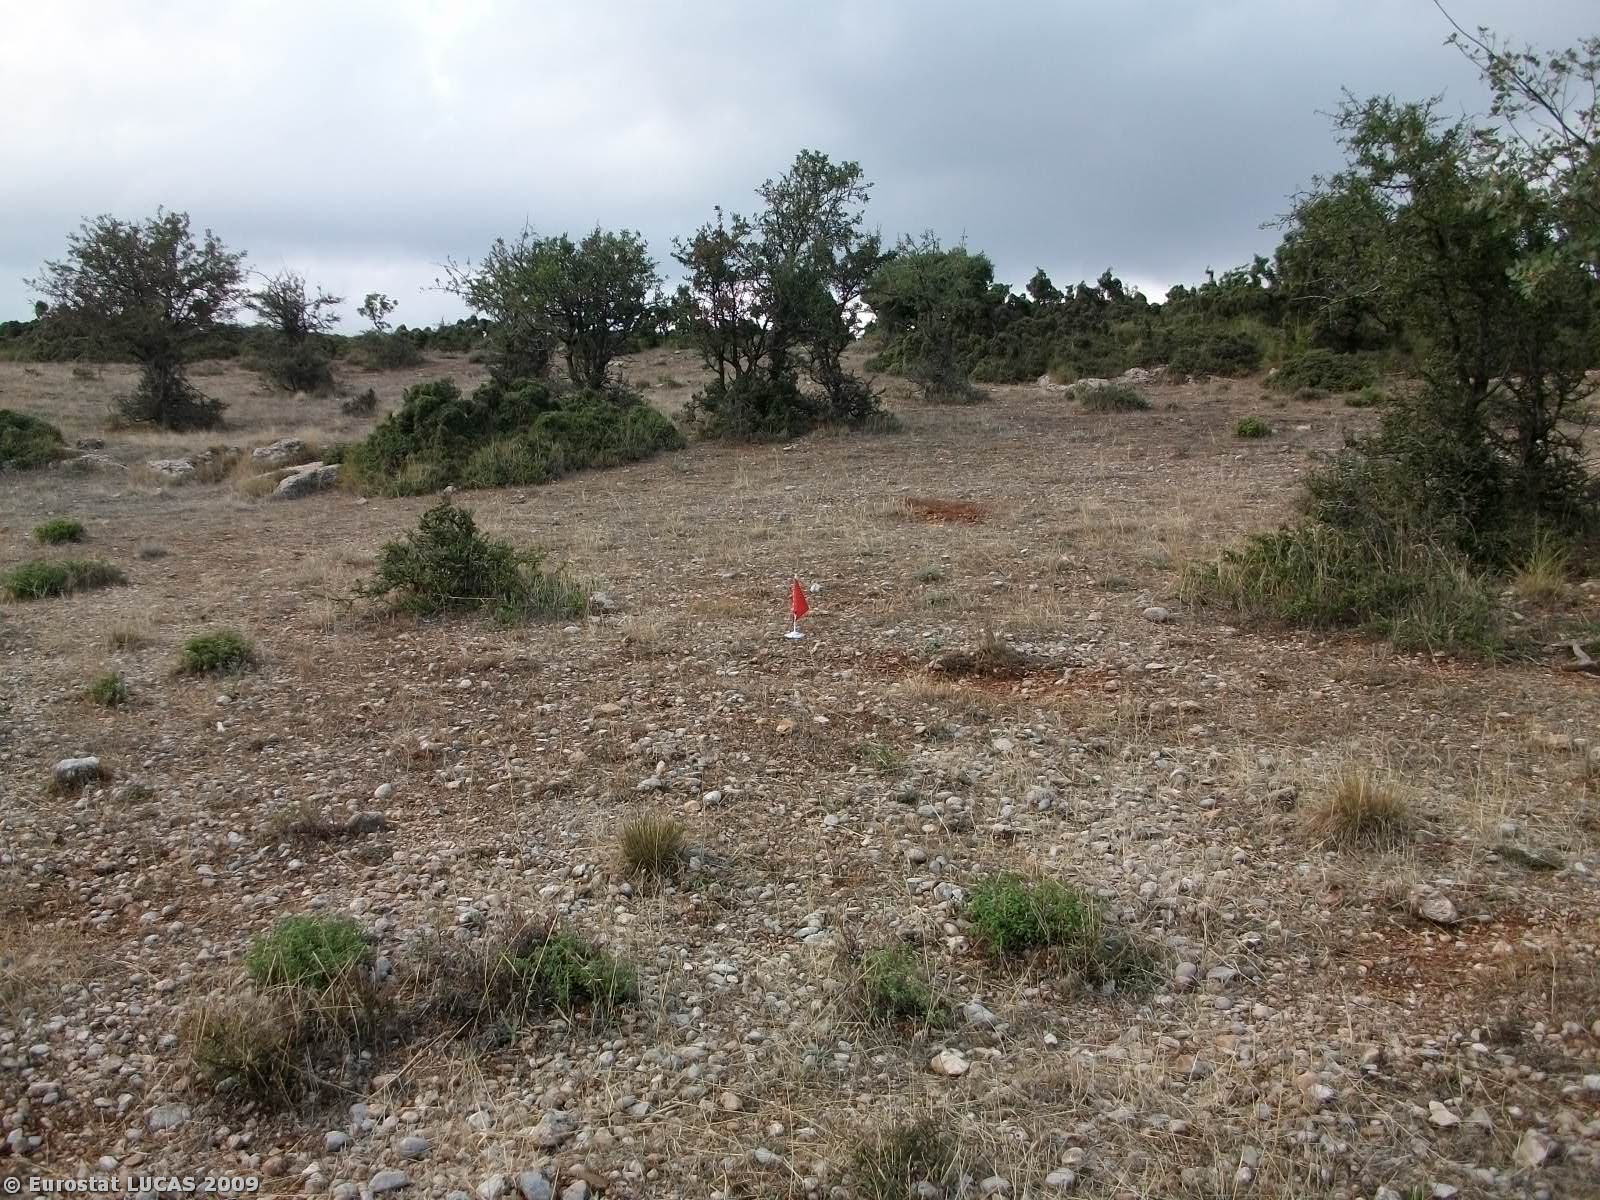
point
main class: Grassland
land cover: Grassland with sparse tree/shrub cover
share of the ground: > 75 %
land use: Agriculture (excluding fallow land and kitchen gardens)
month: September
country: GR
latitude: 37.8504
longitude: 22.5258
